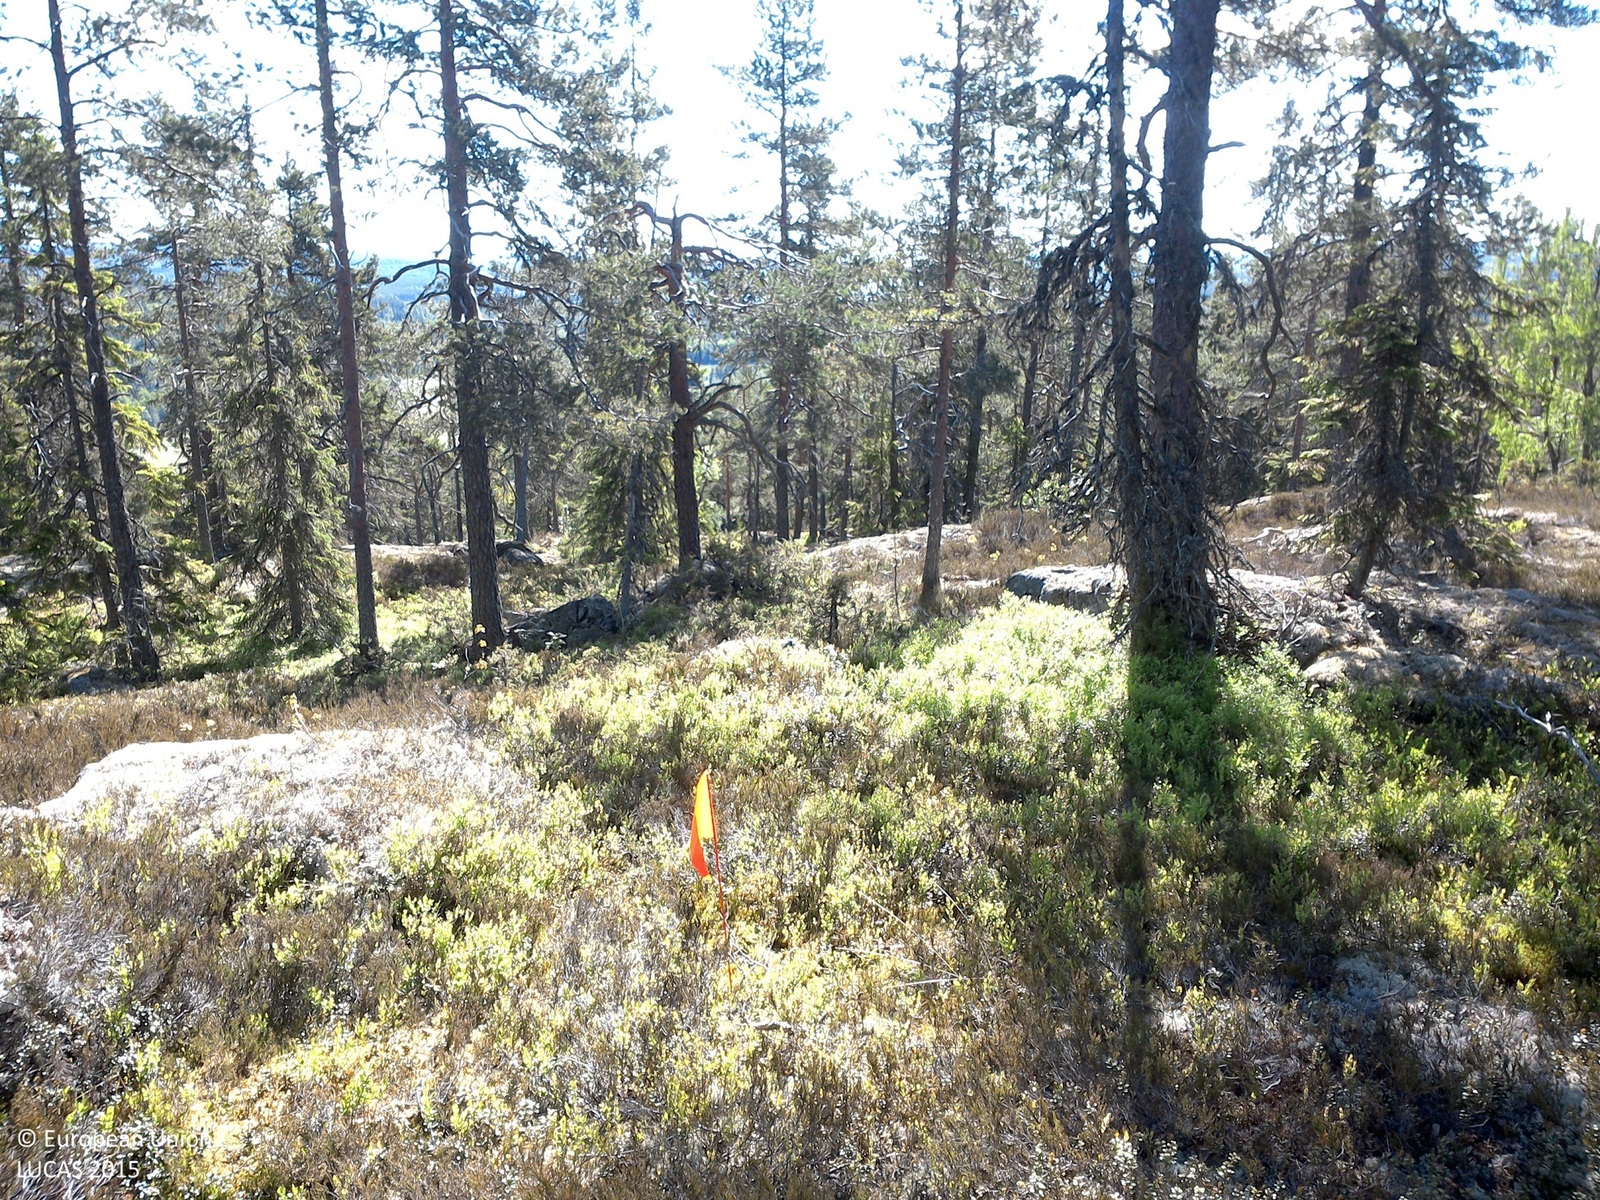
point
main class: Woodland
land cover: Pine dominated coniferous woodland
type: boreal forest
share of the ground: 10 - 25 %
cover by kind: shrubs 70 %, coniferous forest trees 20 %, lichens and mosses 10 %
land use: Forestry
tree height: > 5 m
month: June
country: SE
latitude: 62.6834
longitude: 17.7731
